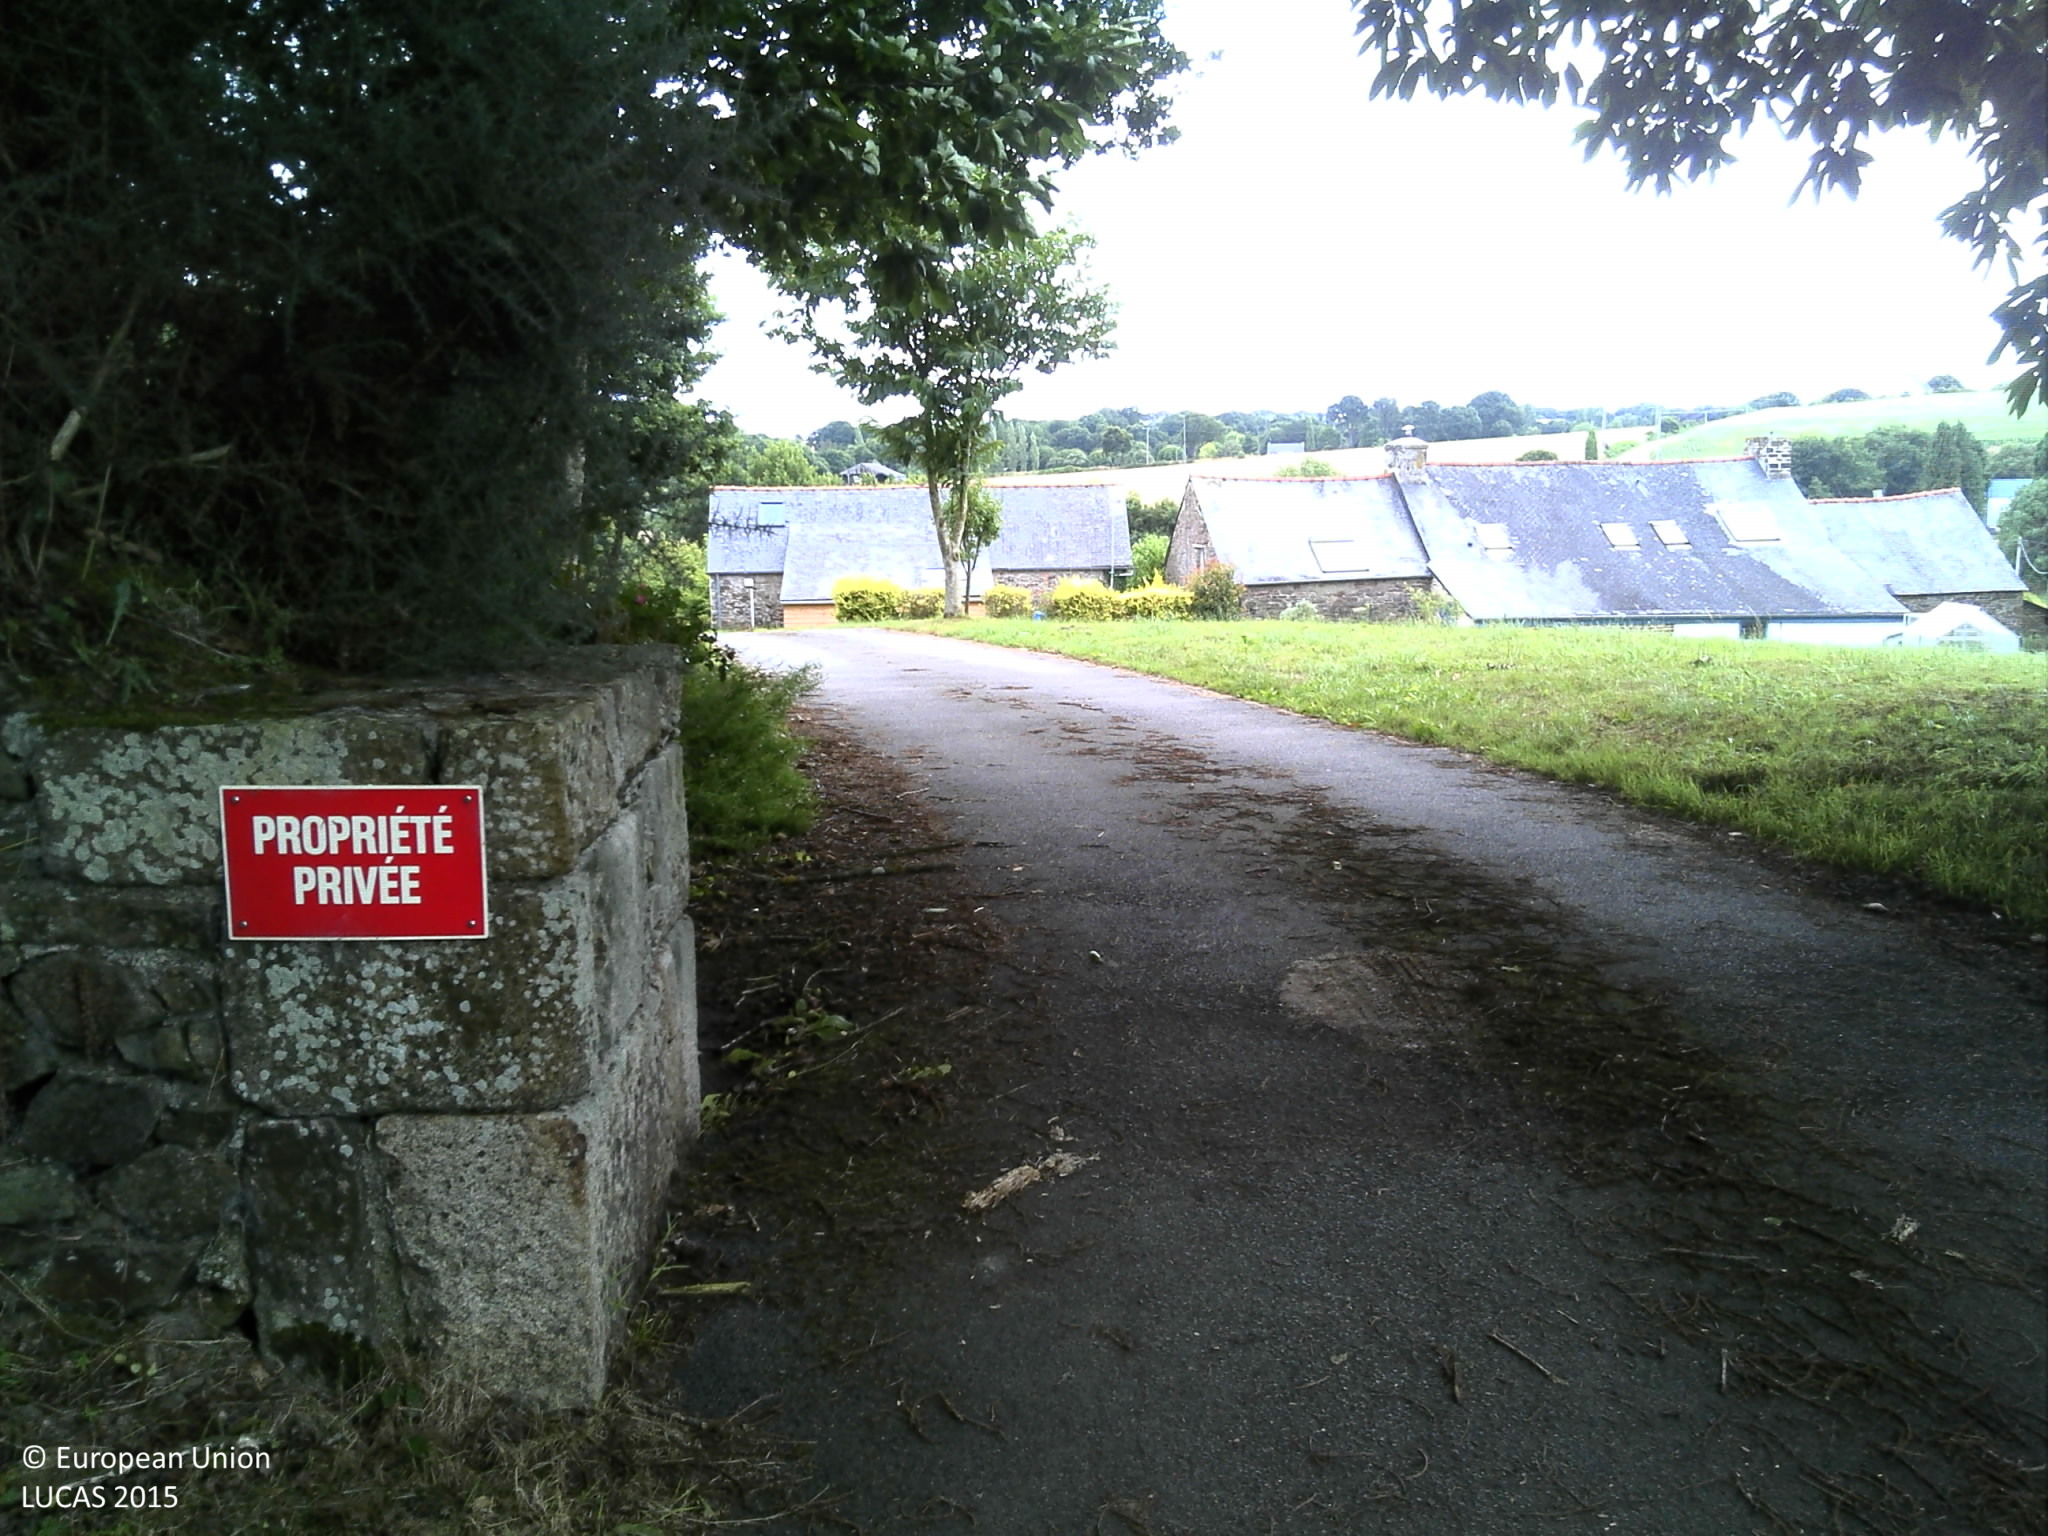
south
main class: Grassland
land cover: Grassland without tree/shrub cover
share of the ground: > 75 %
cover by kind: herbaceous plants 100 %
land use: Residential
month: July
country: FR
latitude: 48.2707
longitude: -3.5932
